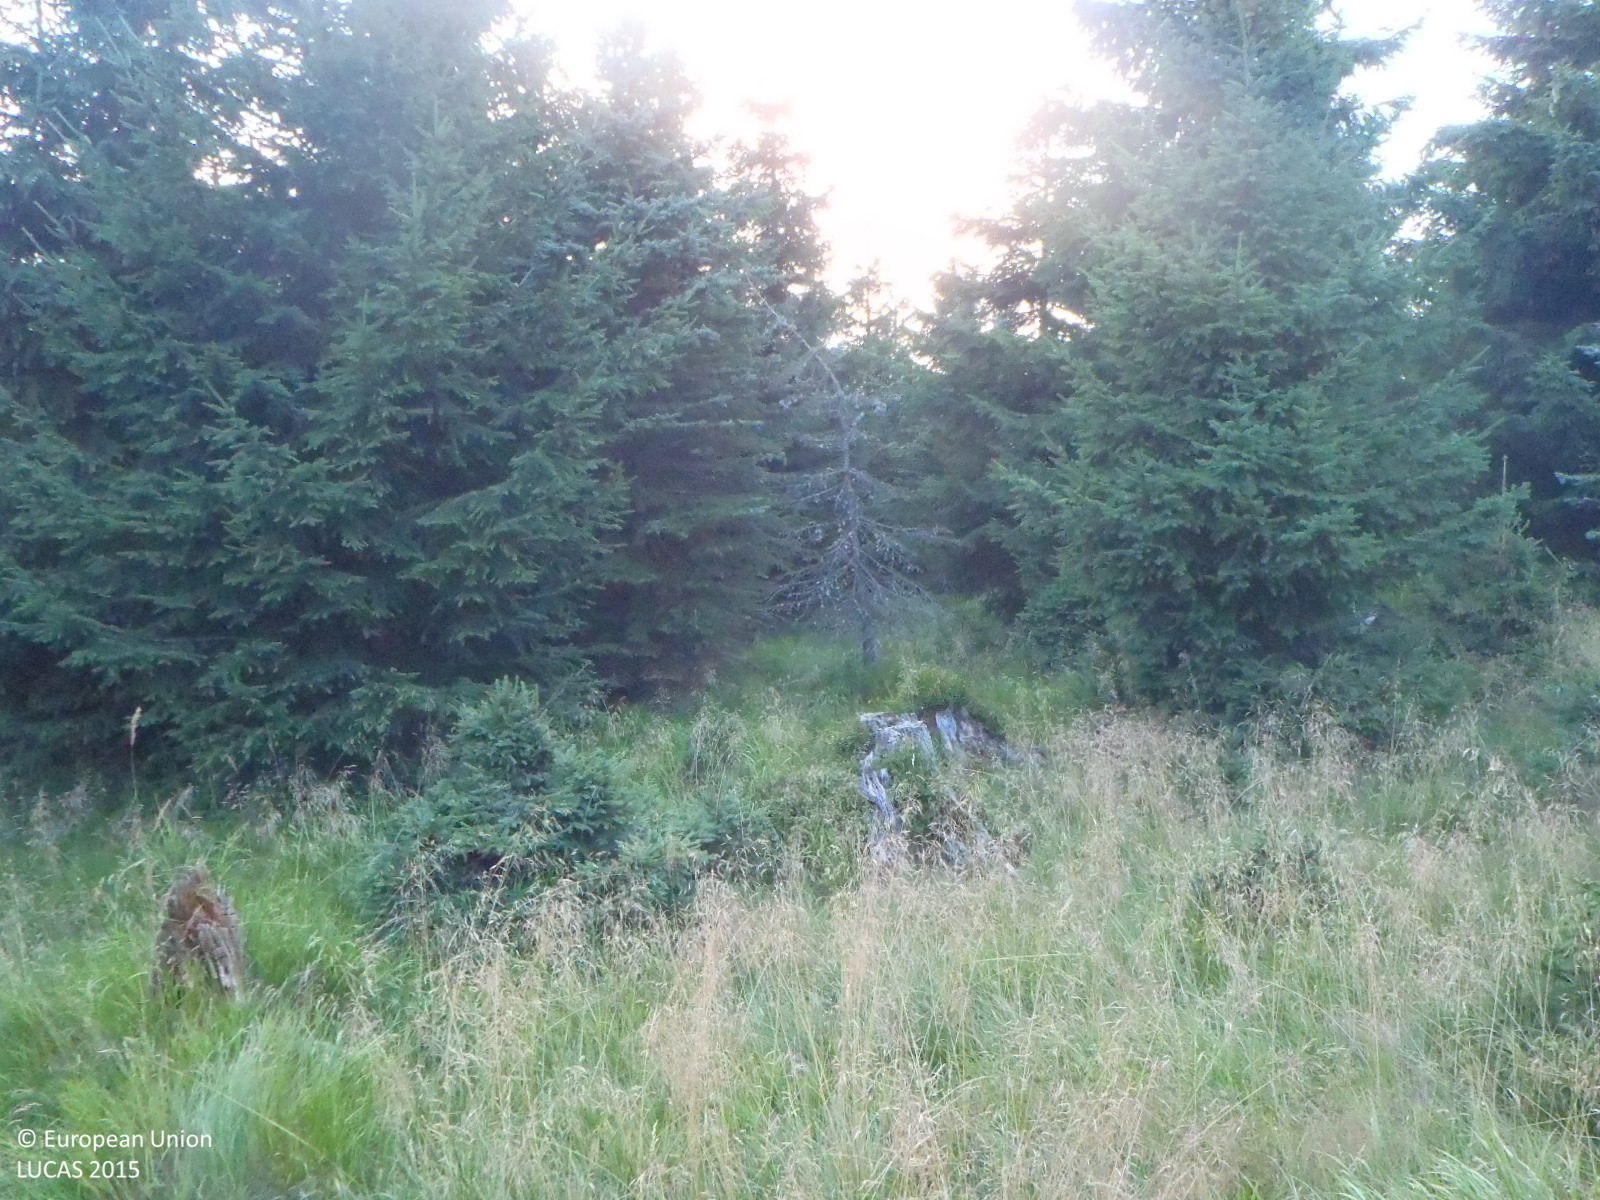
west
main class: Woodland
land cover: Spruce dominated coniferous woodland
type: hemiboreal forest and nemoral coniferous forest and mixed broadleaved-coniferous forest
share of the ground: > 75 %
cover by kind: coniferous forest trees 80 %, herbaceous plants 15 %, shrubs 5 %
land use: Forestry
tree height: > 5 m
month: August
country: CZ
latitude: 50.8205
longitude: 15.2414
